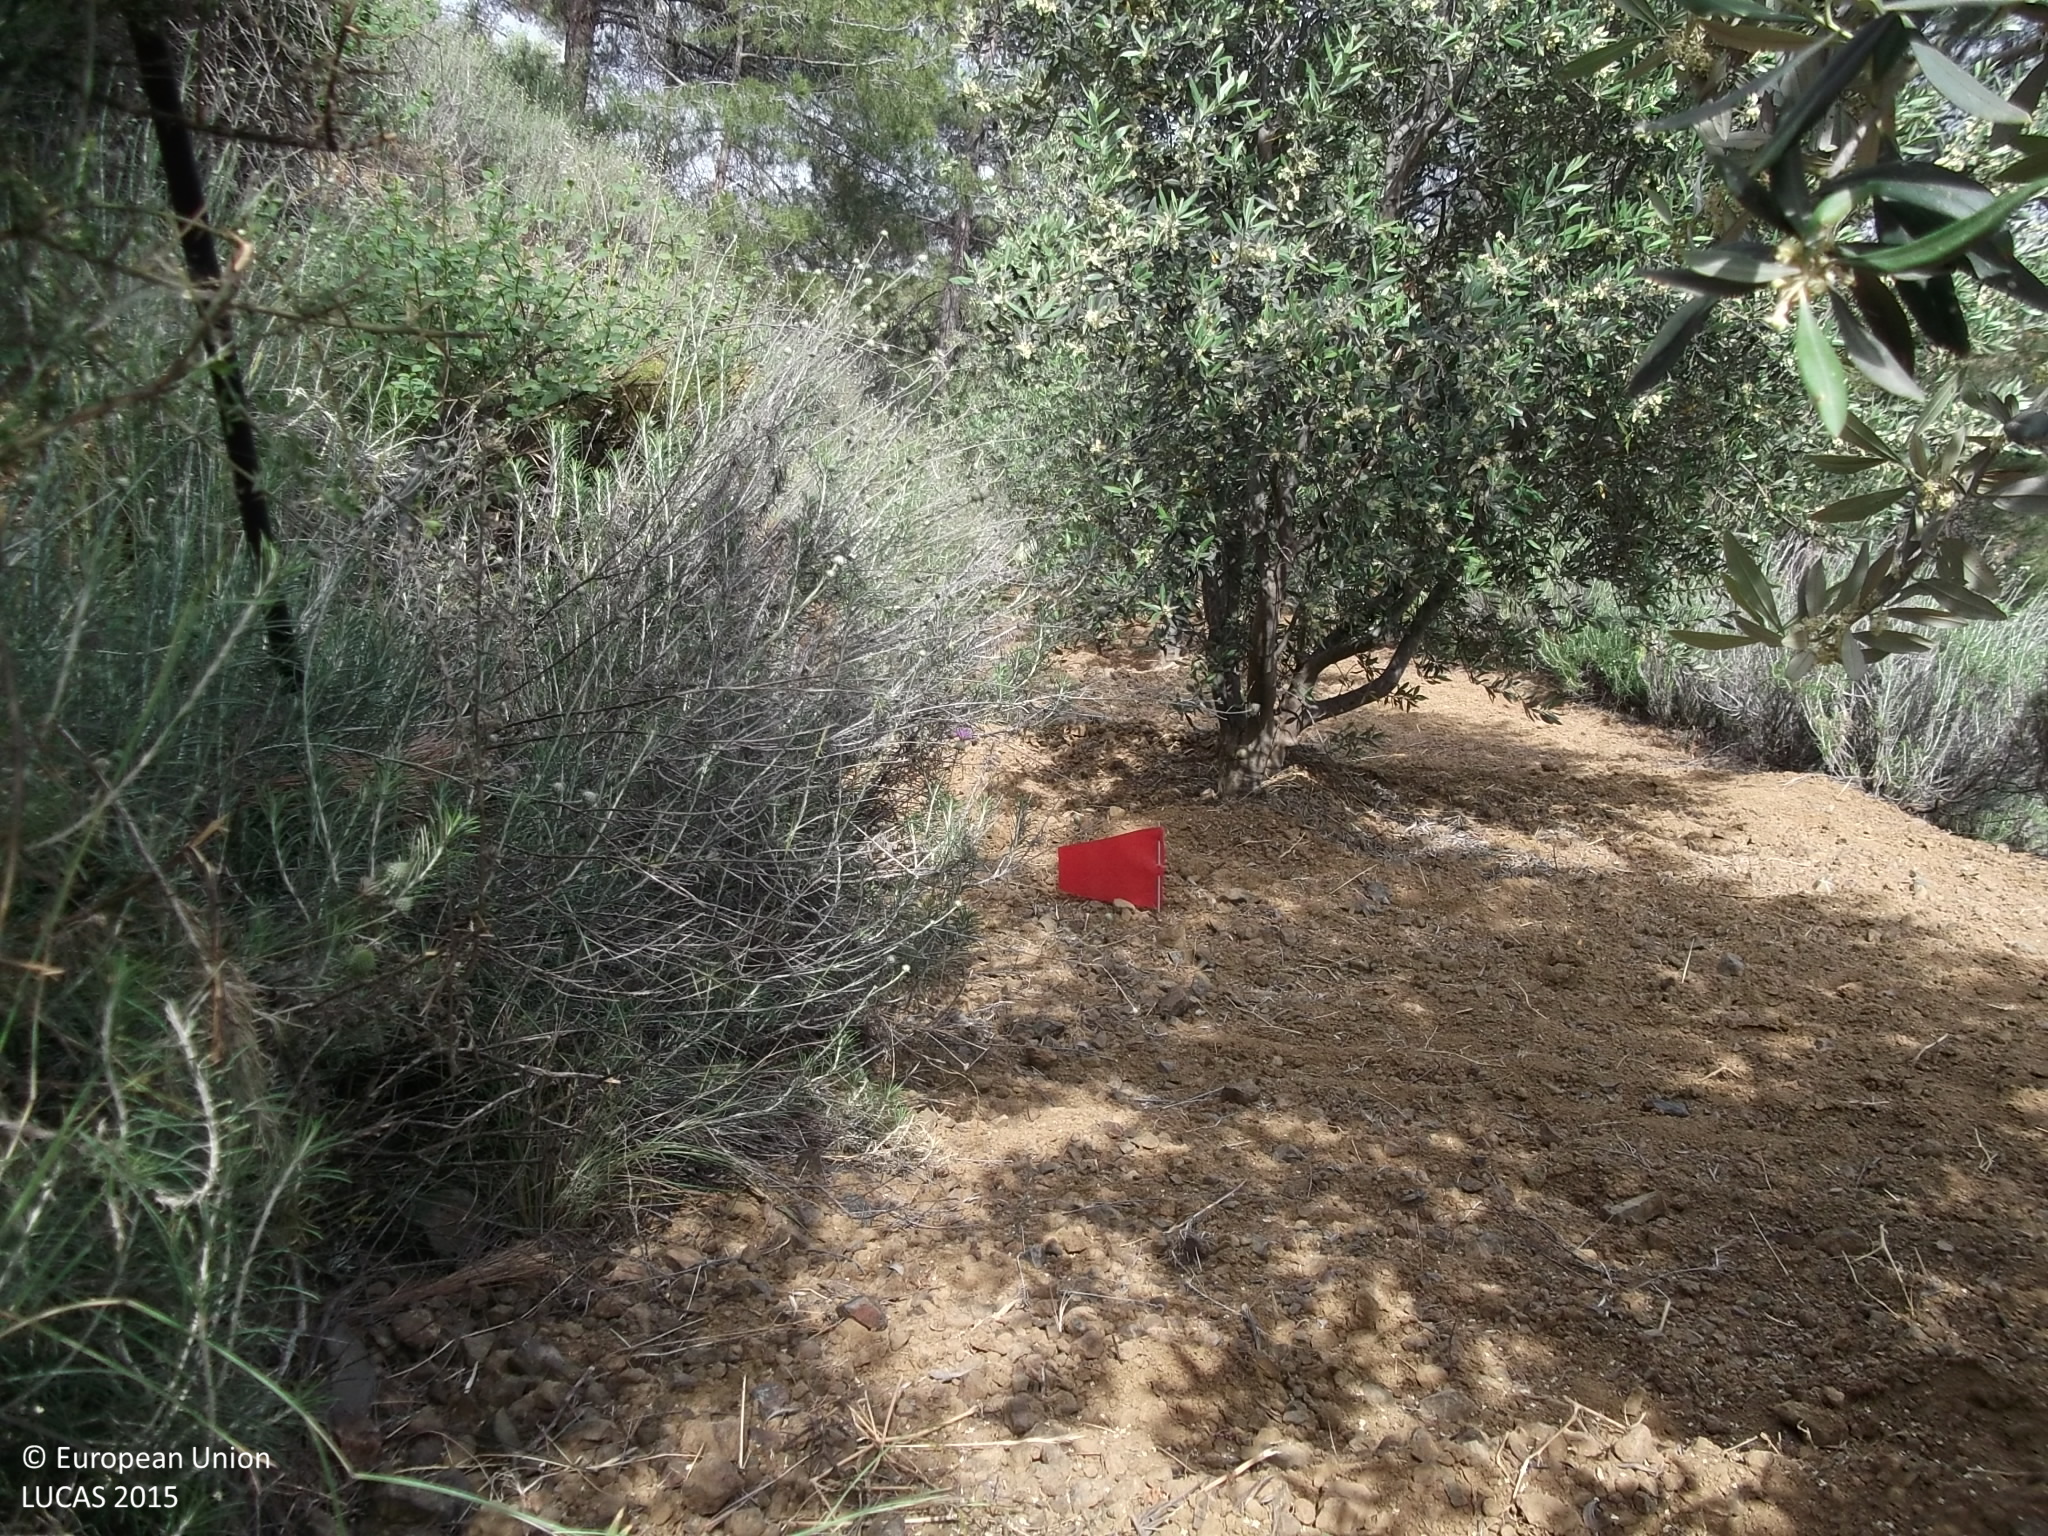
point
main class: Cropland
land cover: Olive groves
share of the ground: 50 - 75 %
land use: Agriculture (excluding fallow land and kitchen gardens)
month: April
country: CY
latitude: 34.8605
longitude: 33.1793
